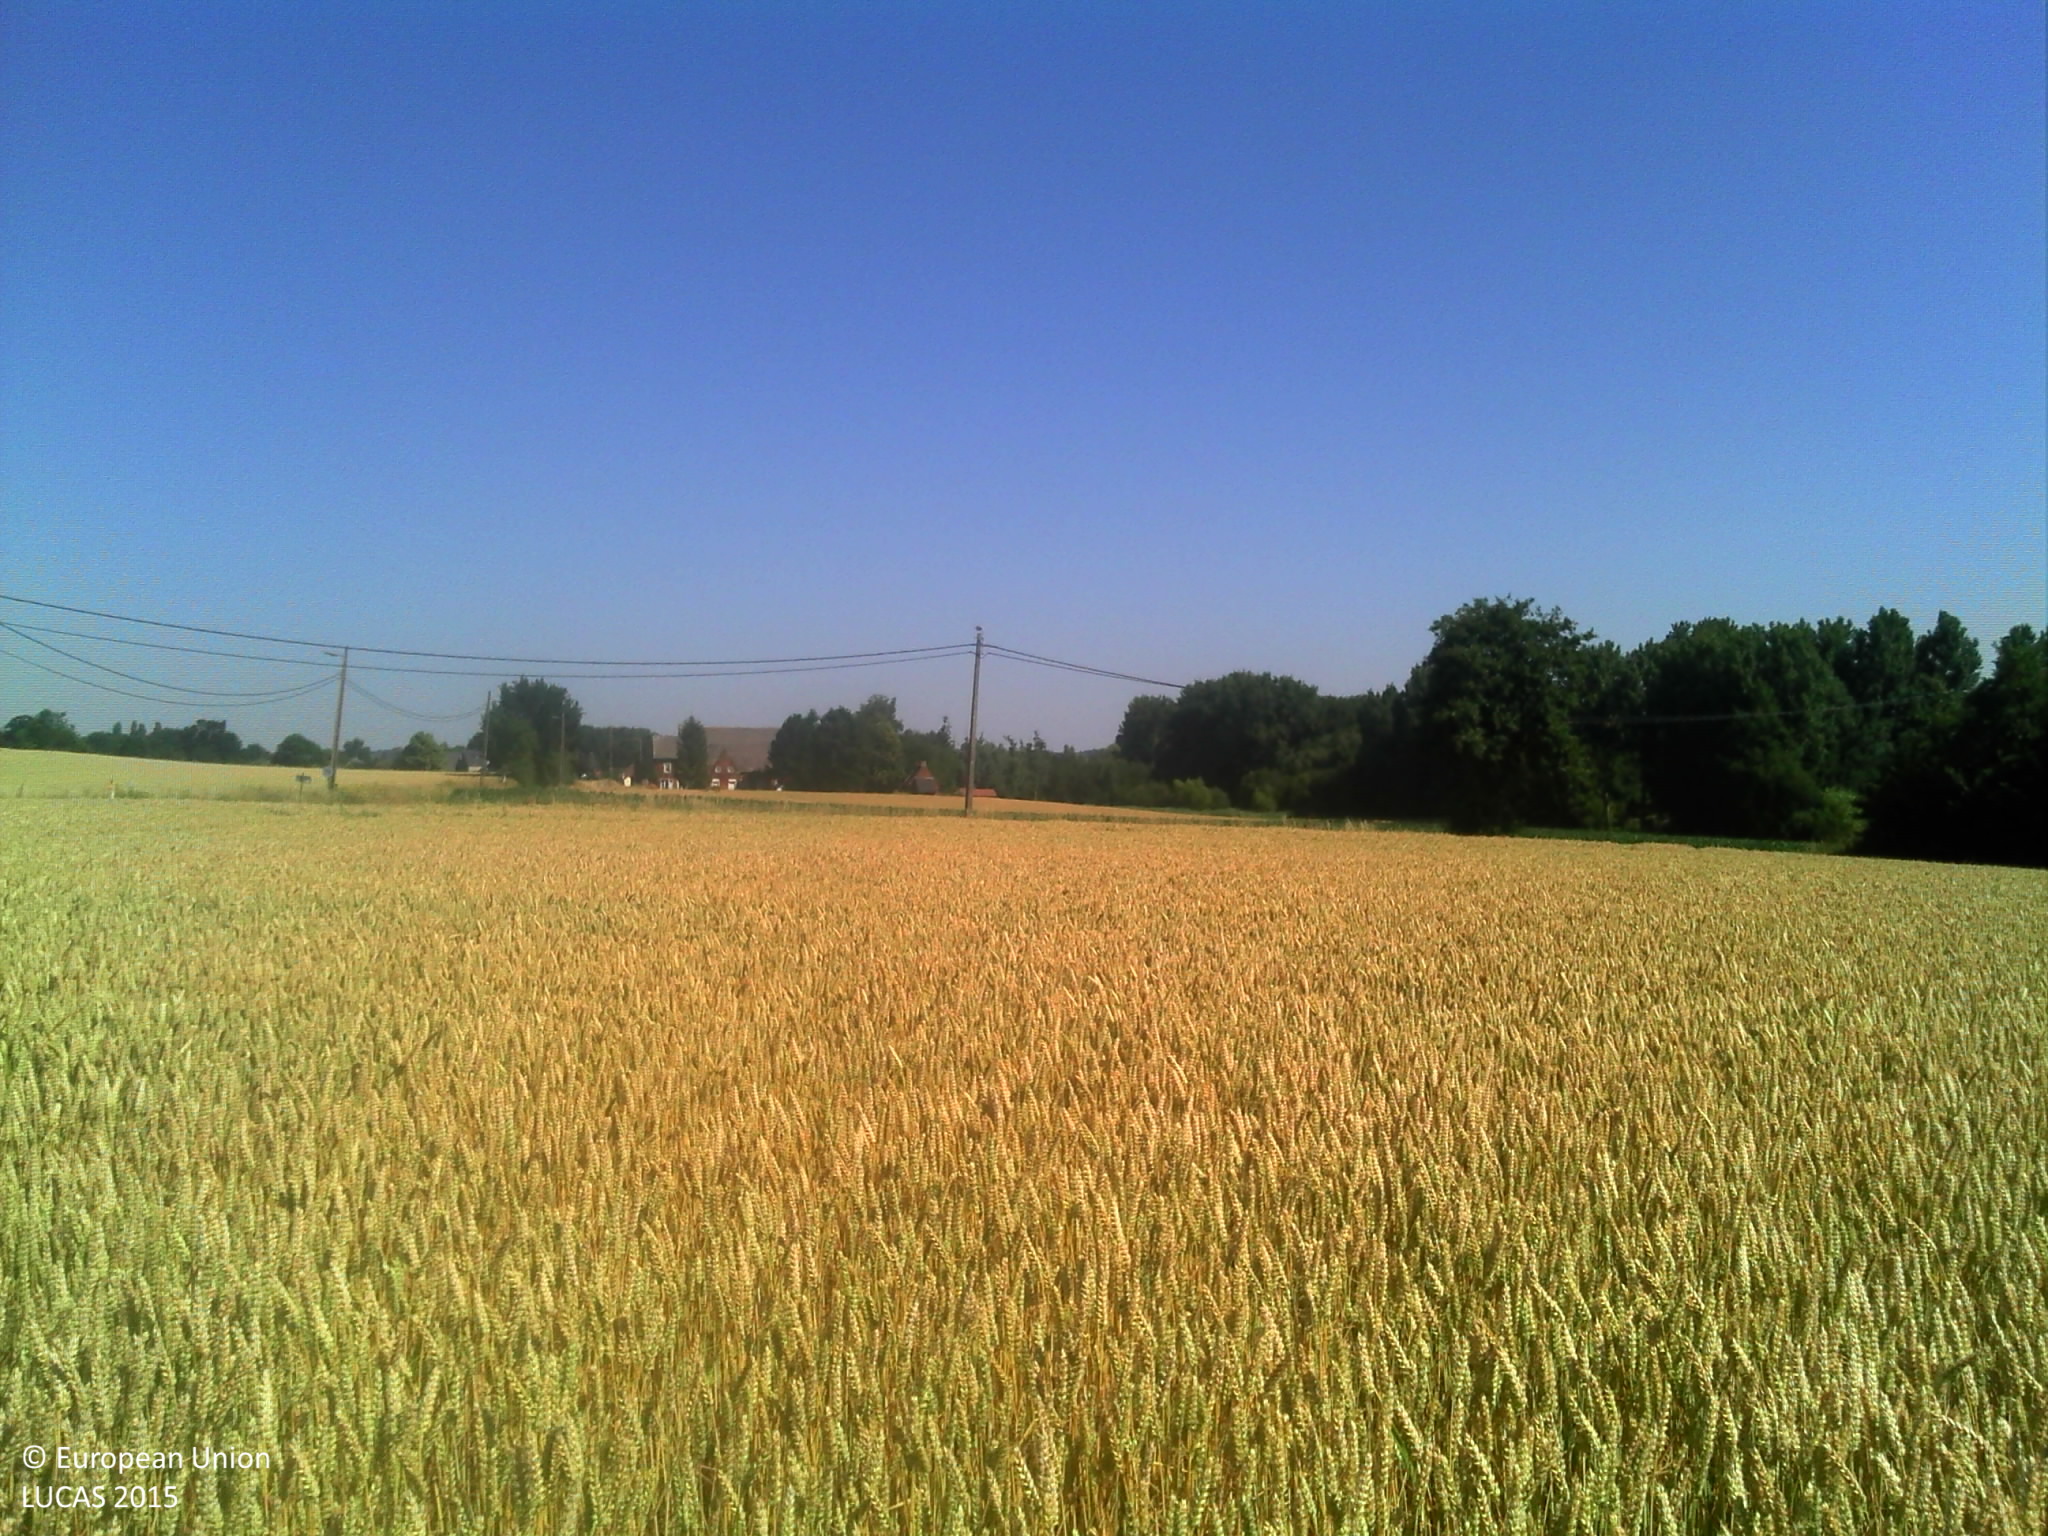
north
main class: Cropland
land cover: Common wheat
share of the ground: > 75 %
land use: Agriculture (excluding fallow land and kitchen gardens)
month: July
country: BE
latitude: 50.8205
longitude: 4.7586
